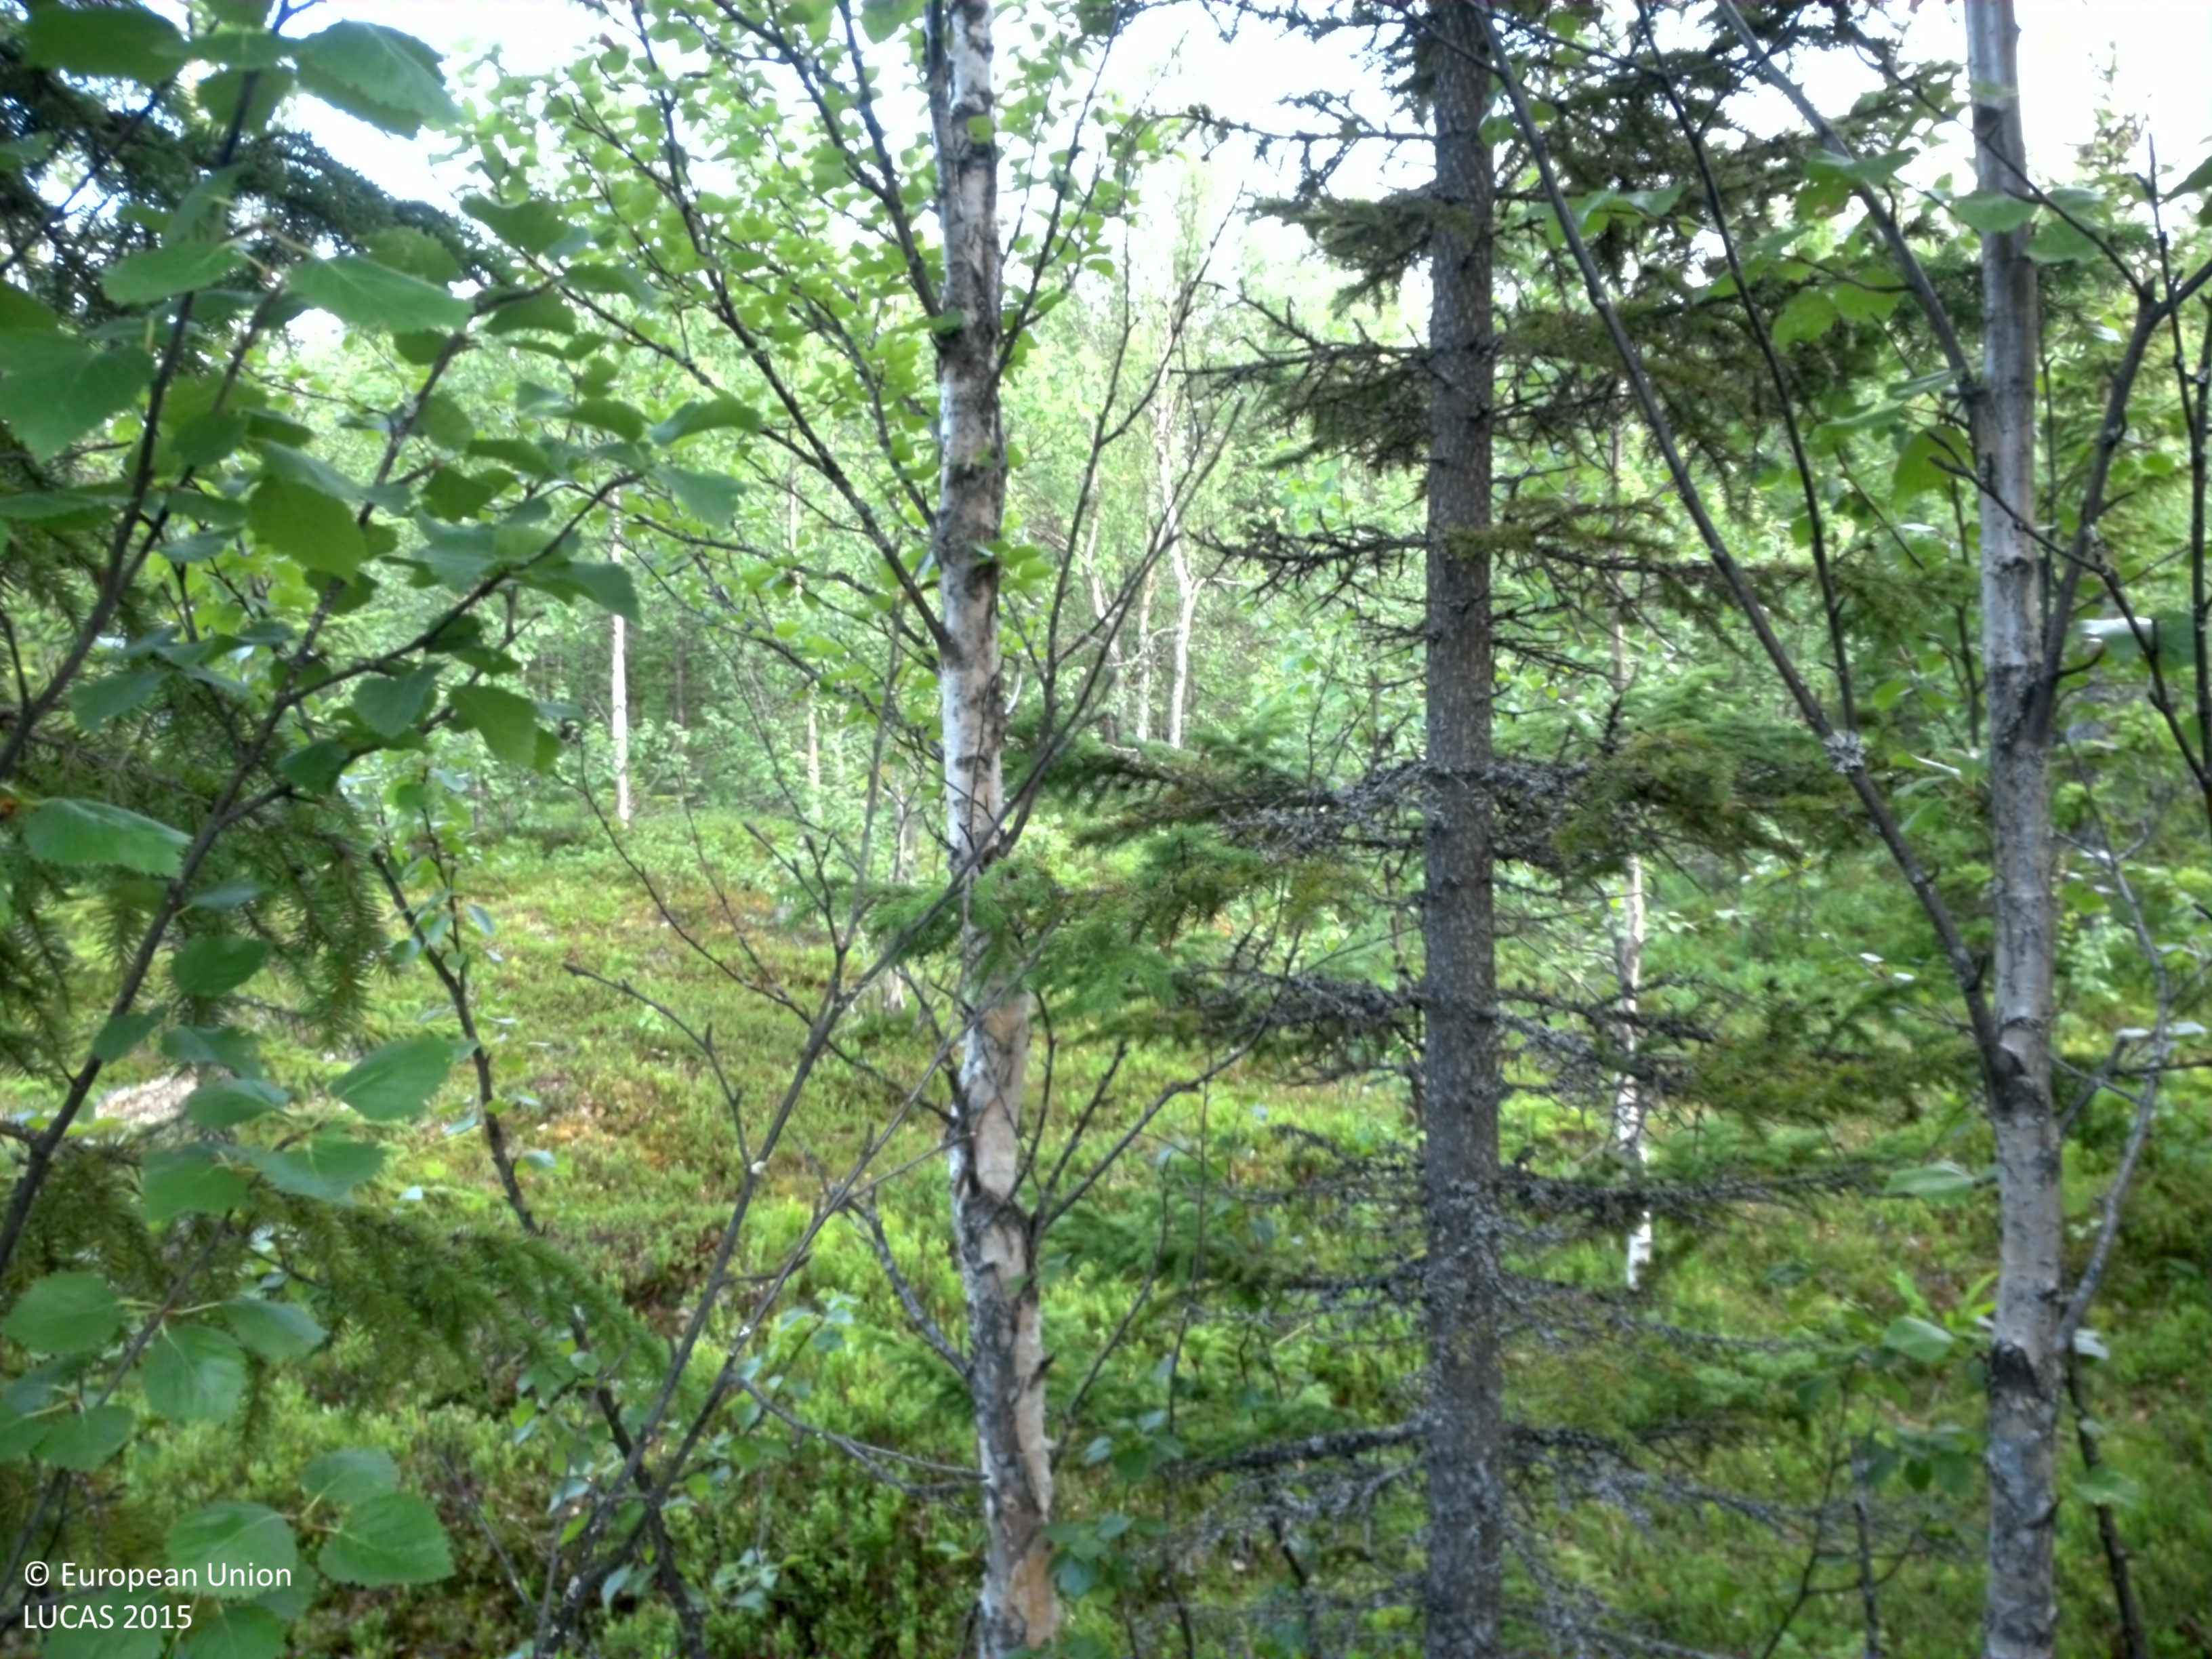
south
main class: Woodland
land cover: Spruce dominated mixed woodland
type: boreal forest
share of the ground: 25 - 50 %
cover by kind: shrubs 55 %, broadleaved forest trees 25 %, coniferous forest trees 10 %, herbaceous plants 5 %, lichens and mosses 5 %
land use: Forestry
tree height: > 5 m
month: August
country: SE
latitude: 64.8621
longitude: 16.0638
